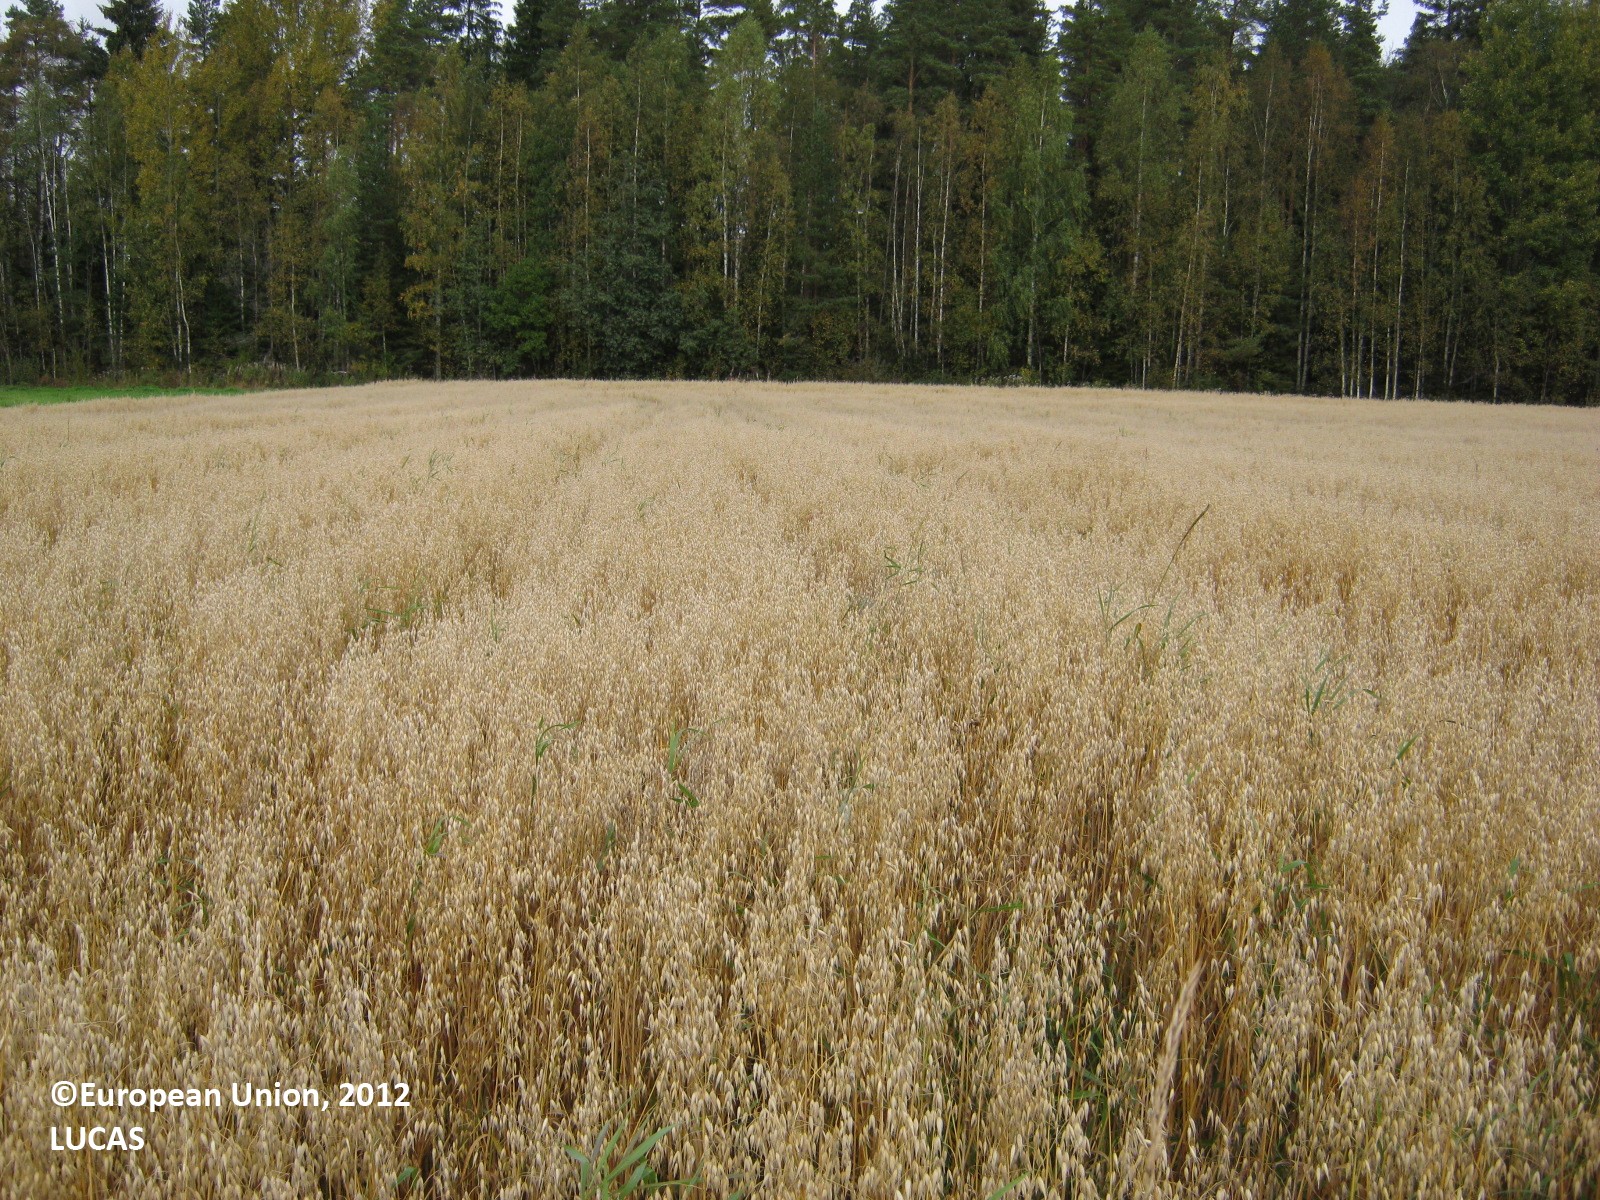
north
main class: Cropland
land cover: Oats
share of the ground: > 75 %
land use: Agriculture (excluding fallow land and kitchen gardens)
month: September
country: FI
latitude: 60.6851
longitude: 27.6389
